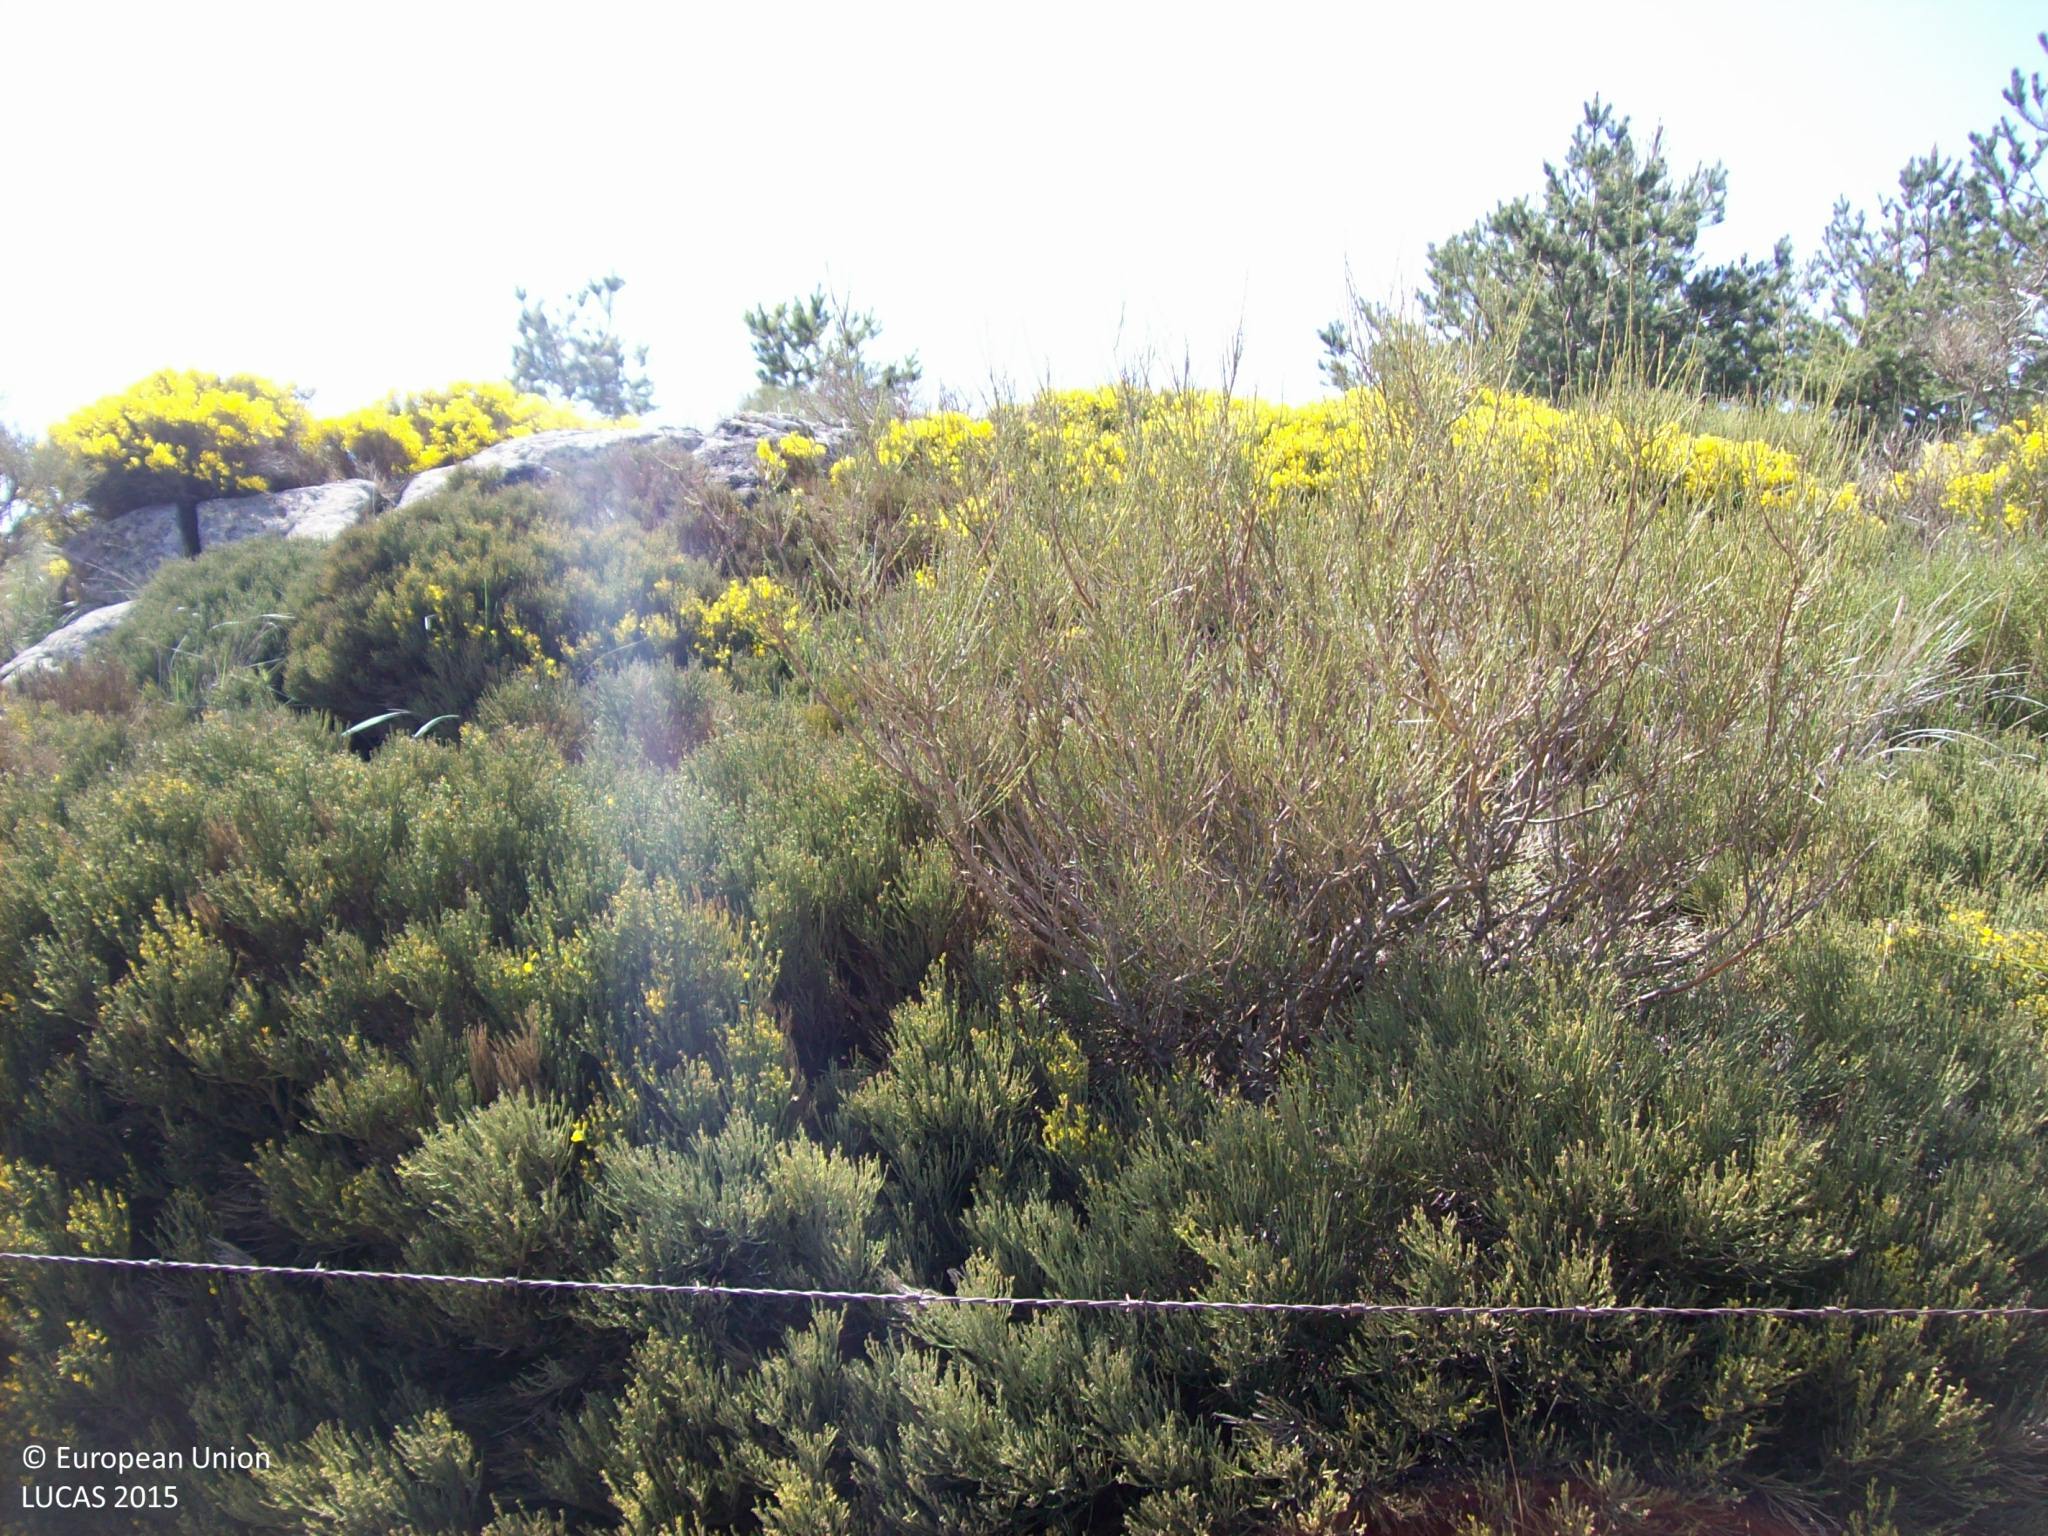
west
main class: Shrubland
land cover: Shrubland without tree cover
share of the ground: > 75 %
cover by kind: shrubs 95 %, herbaceous plants 5 %
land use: Agriculture (excluding fallow land and kitchen gardens)
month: May
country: ES
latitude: 40.6238
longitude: -4.4377
